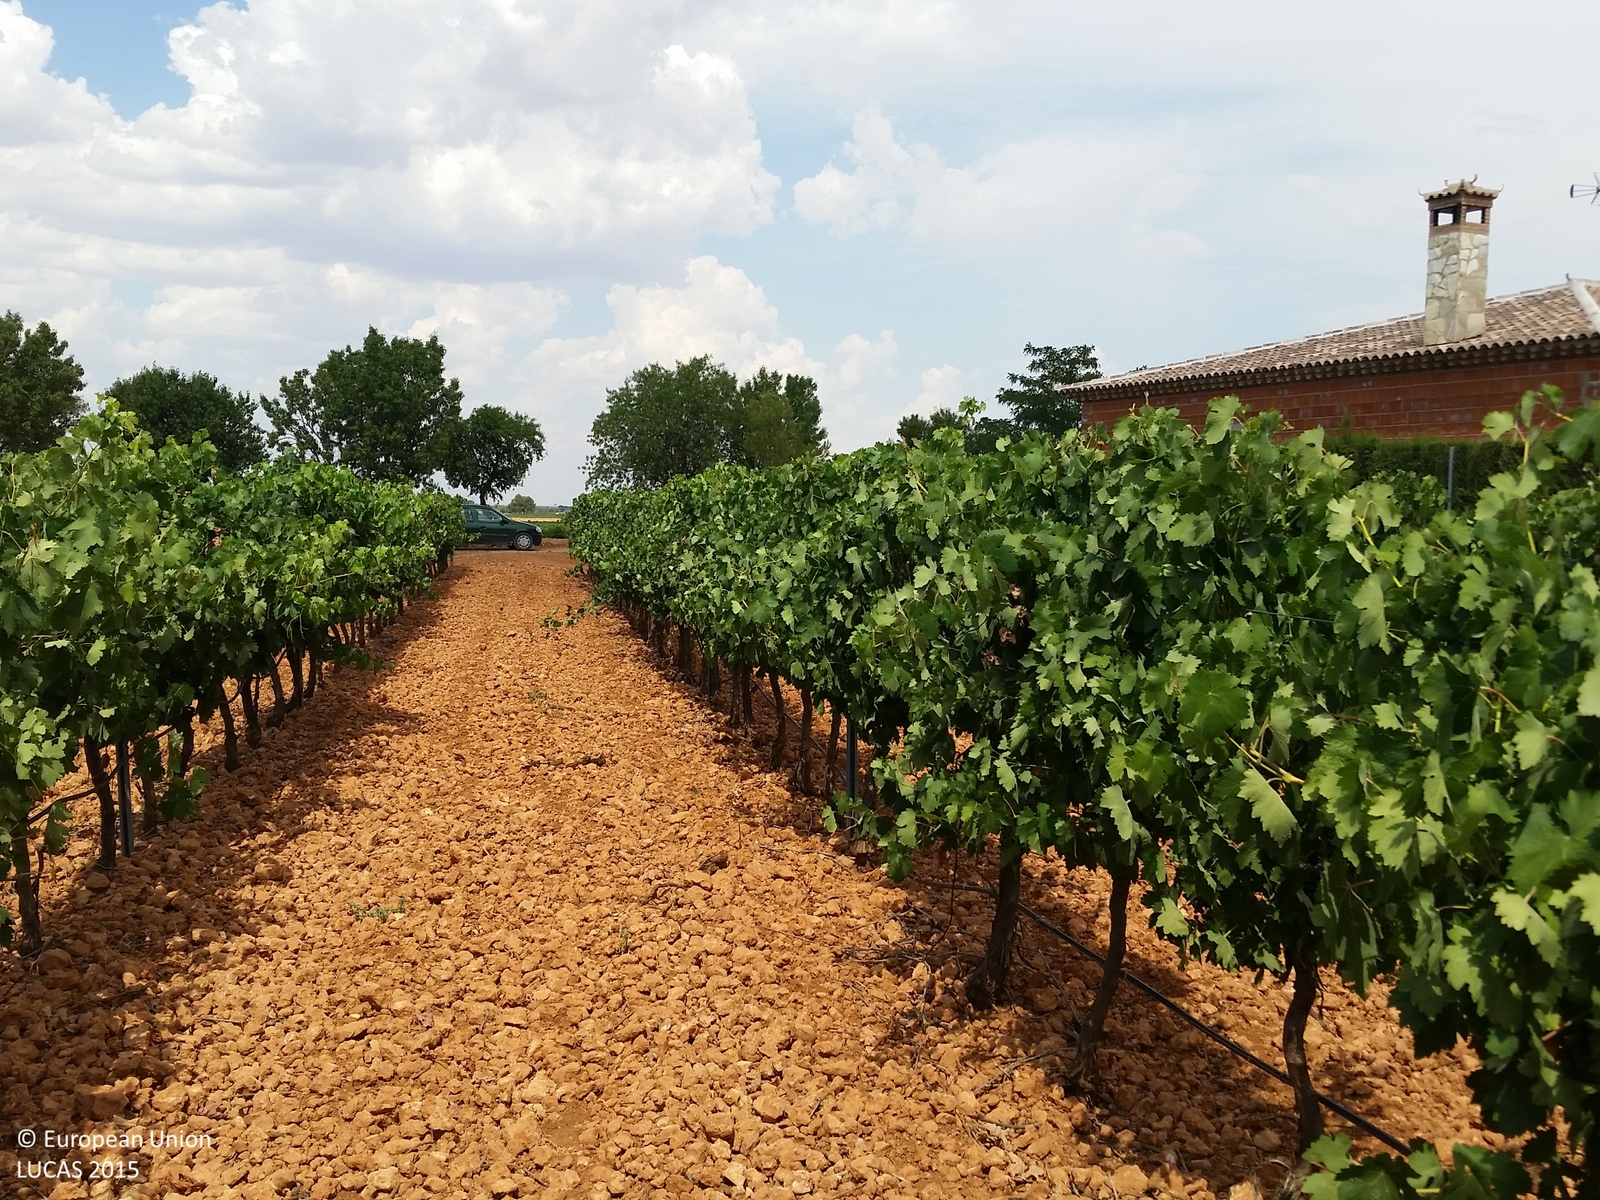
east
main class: Cropland
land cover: Vineyards
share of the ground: 50 - 75 %
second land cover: Other bare soil
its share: > 75 %
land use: Agriculture (excluding fallow land and kitchen gardens)
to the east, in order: Vineyards; Other bare soil; Artificial constructions in urban areas; Grassland without tree/shrub cover; Lines of trees; Tracks; Lines of trees; Other bare soil
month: July
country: ES
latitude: 39.2257
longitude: -2.6476
